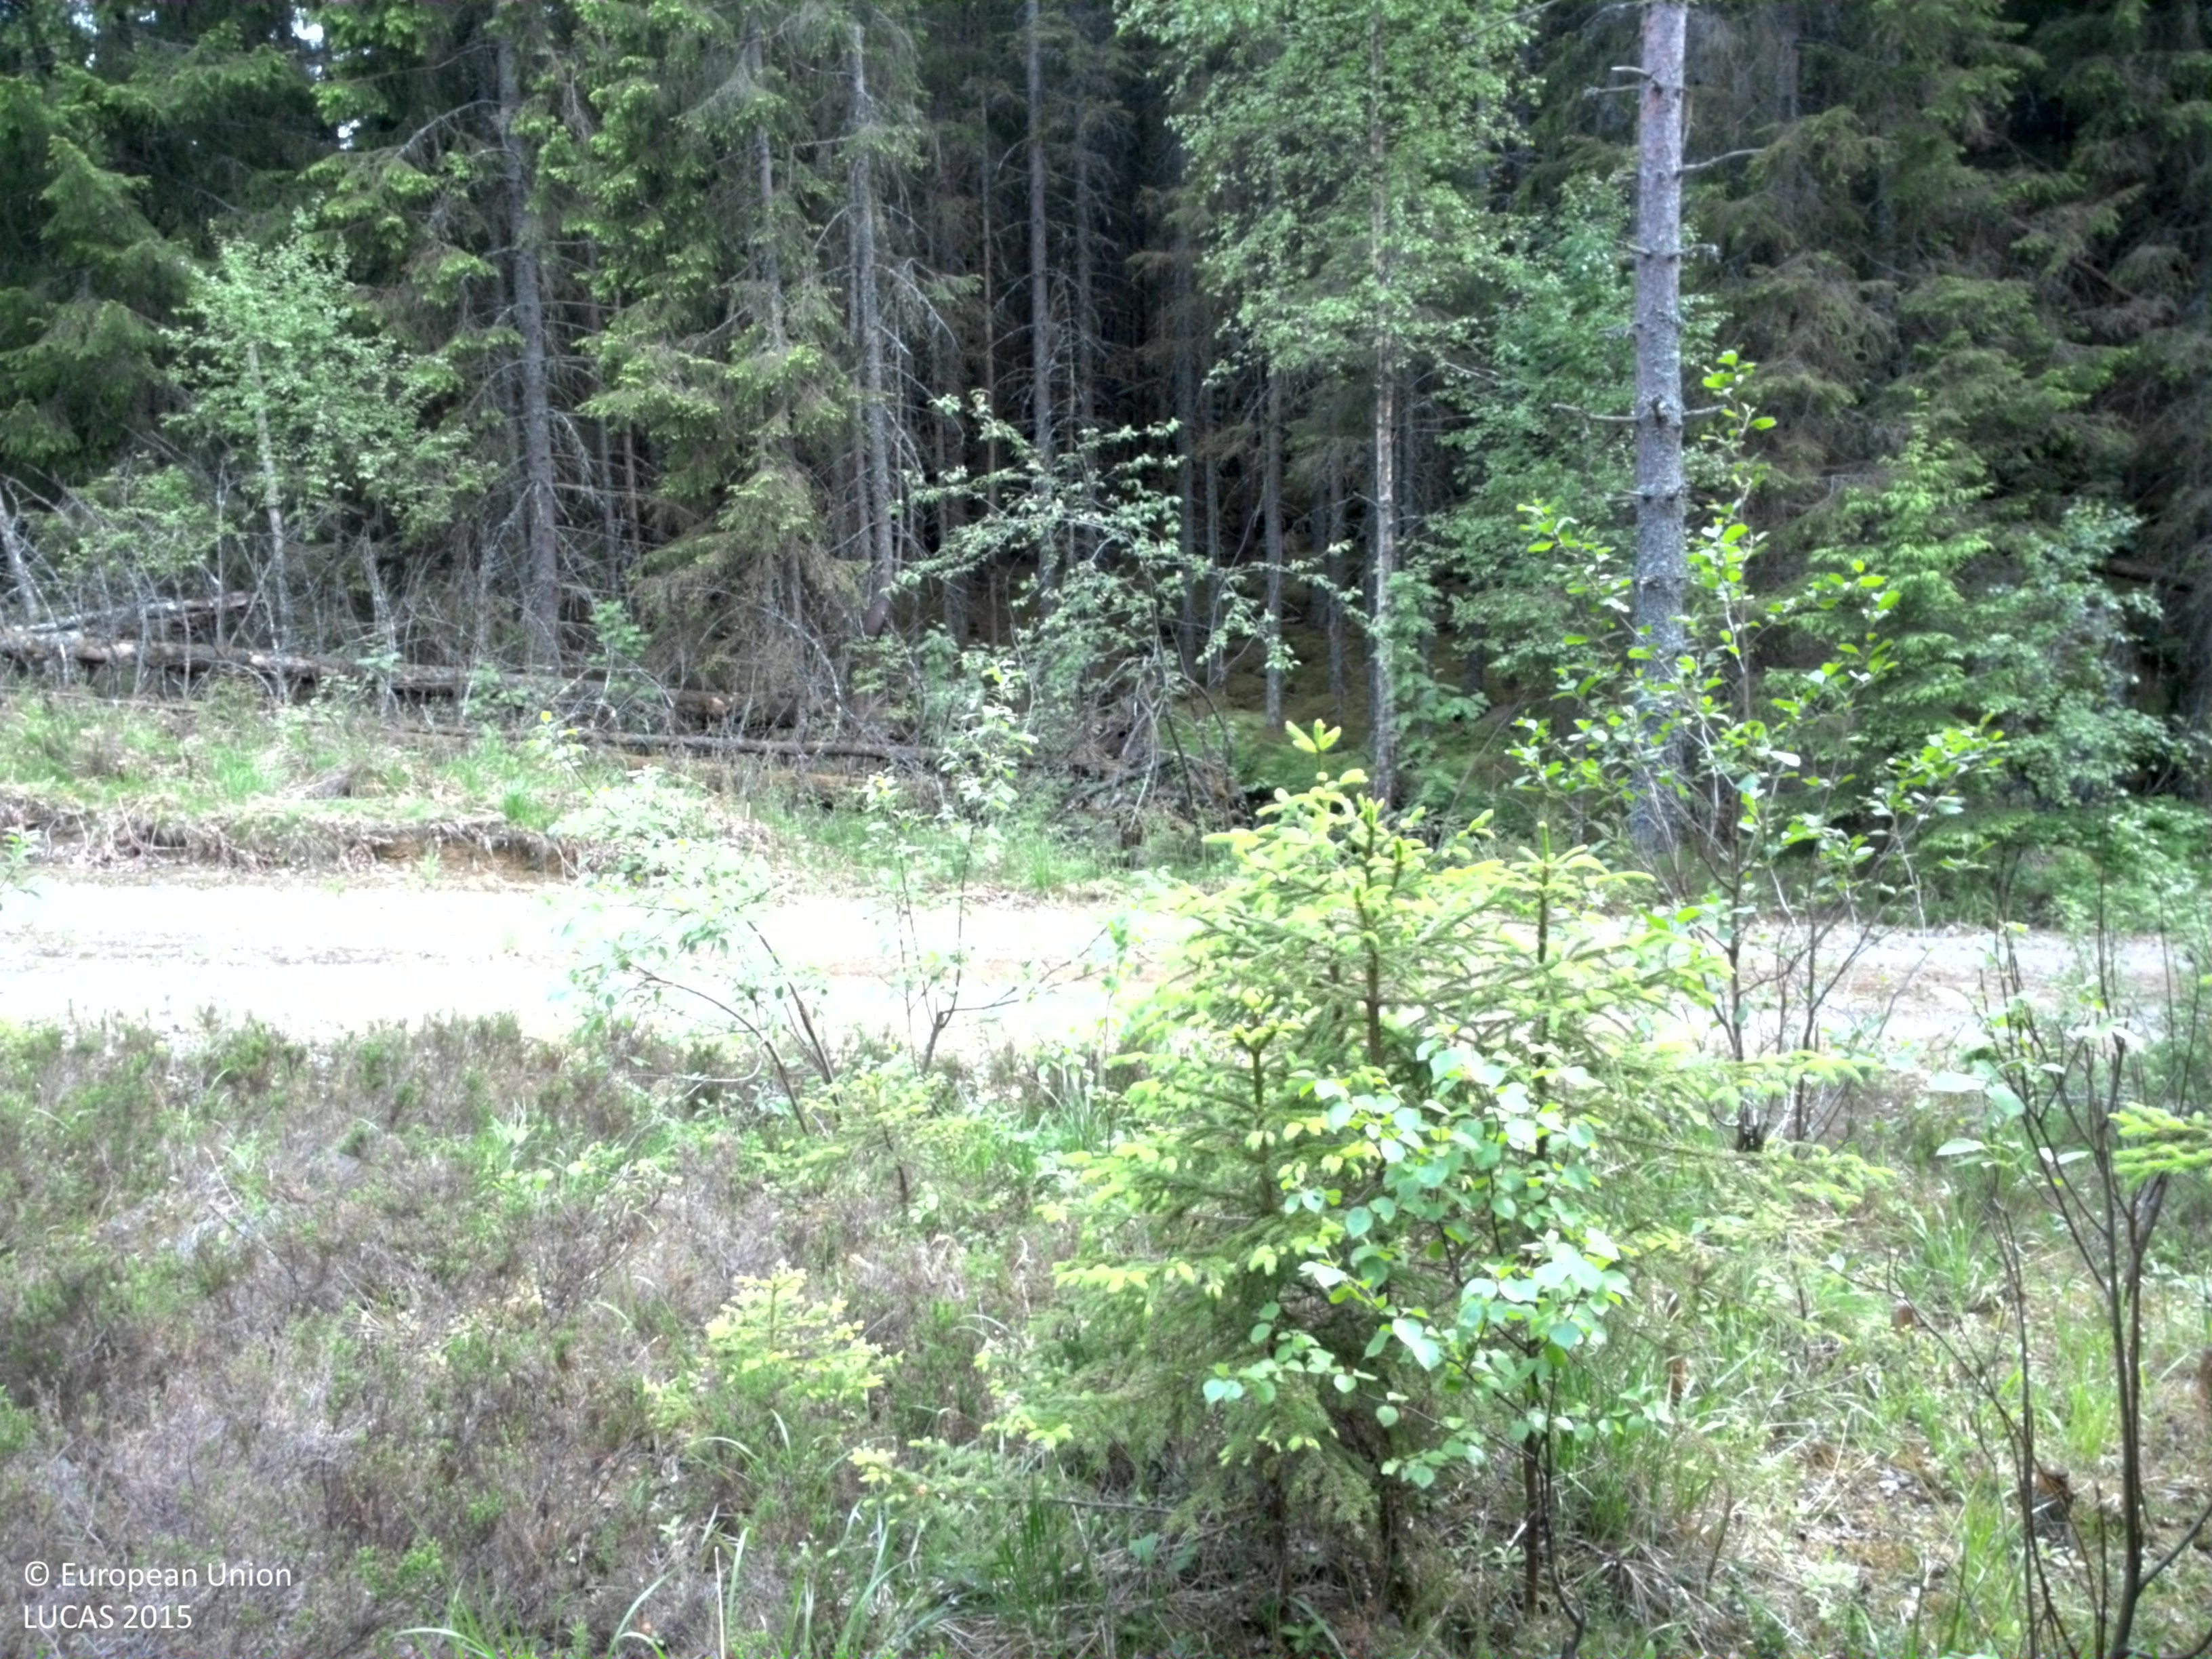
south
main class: Woodland
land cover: Other mixed woodland
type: boreal forest
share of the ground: 50 - 75 %
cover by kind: coniferous forest trees 40 %, broadleaved forest trees 30 %, shrubs 20 %, herbaceous plants 10 %
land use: Forestry
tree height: > 5 m
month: June
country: SE
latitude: 59.6431
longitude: 14.4078
